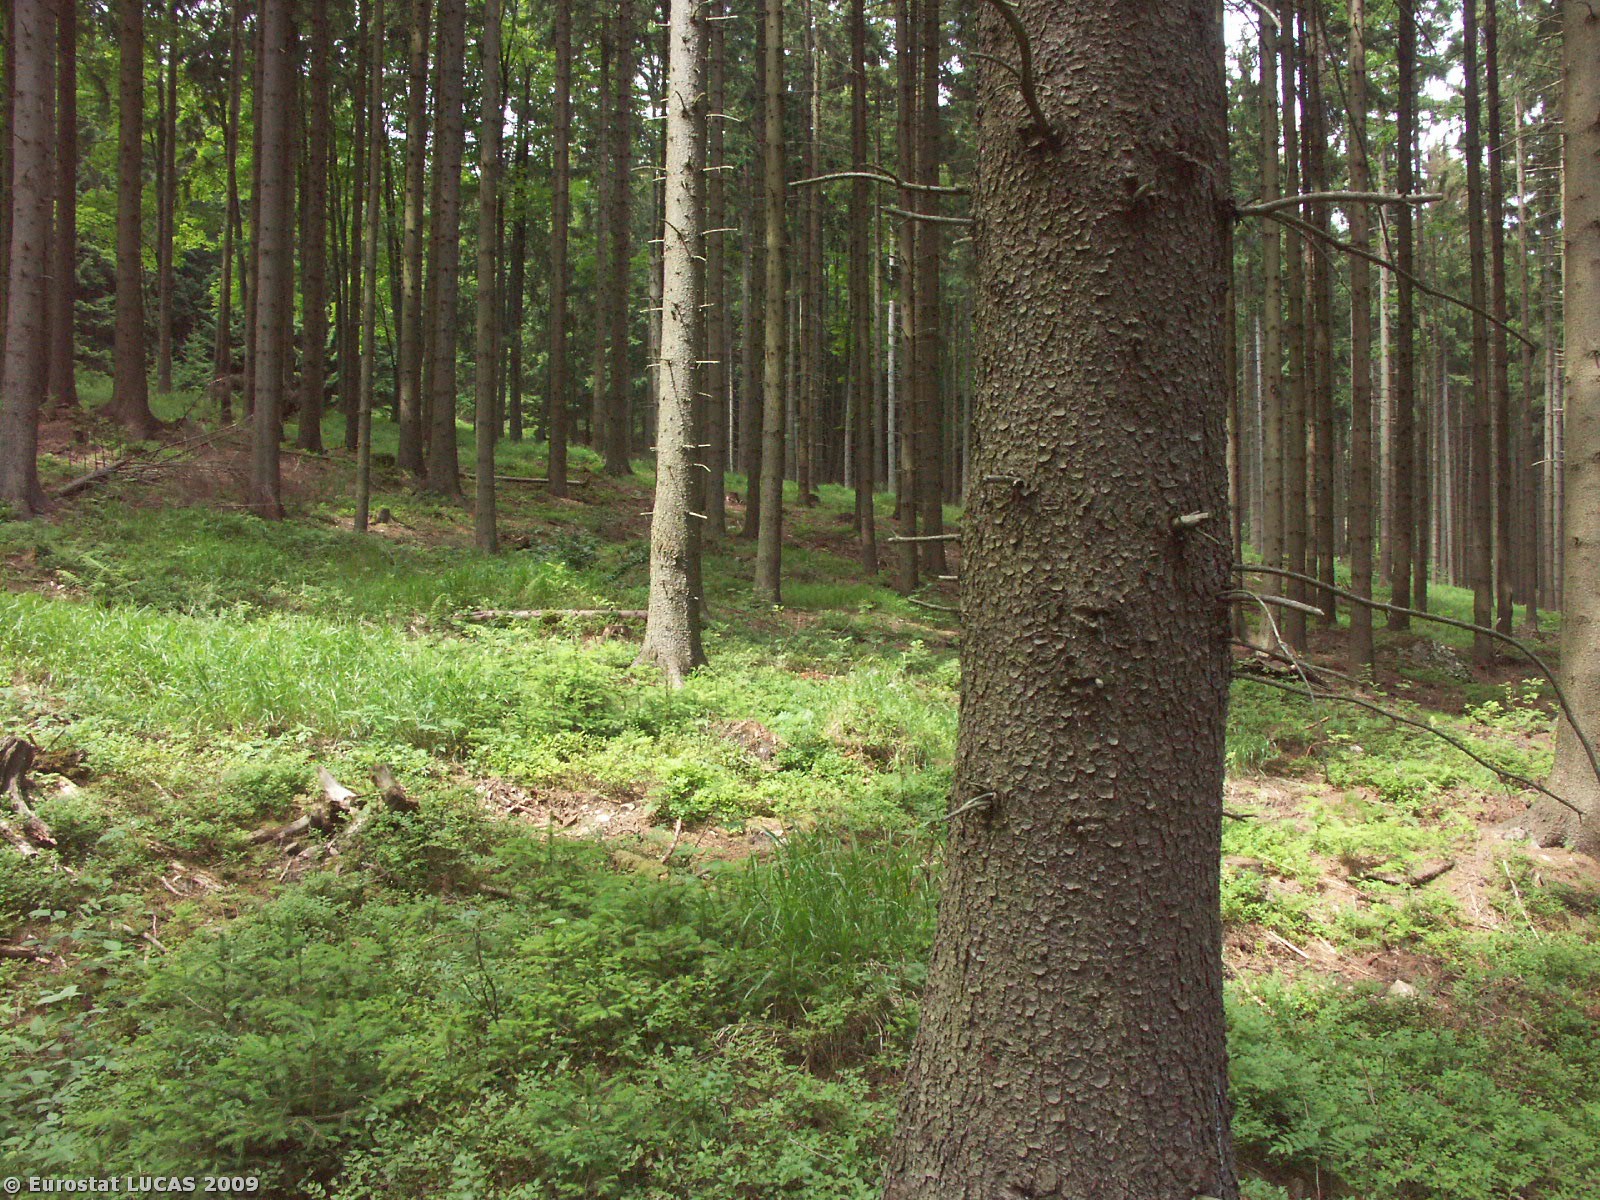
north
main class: Woodland
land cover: Coniferous woodland
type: hemiboreal forest and nemoral coniferous forest and mixed broadleaved-coniferous forest
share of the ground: > 75 %
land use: Forestry
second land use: Nature reserves
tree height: > 5 m
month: July
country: CZ
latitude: 50.0073
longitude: 17.2528
